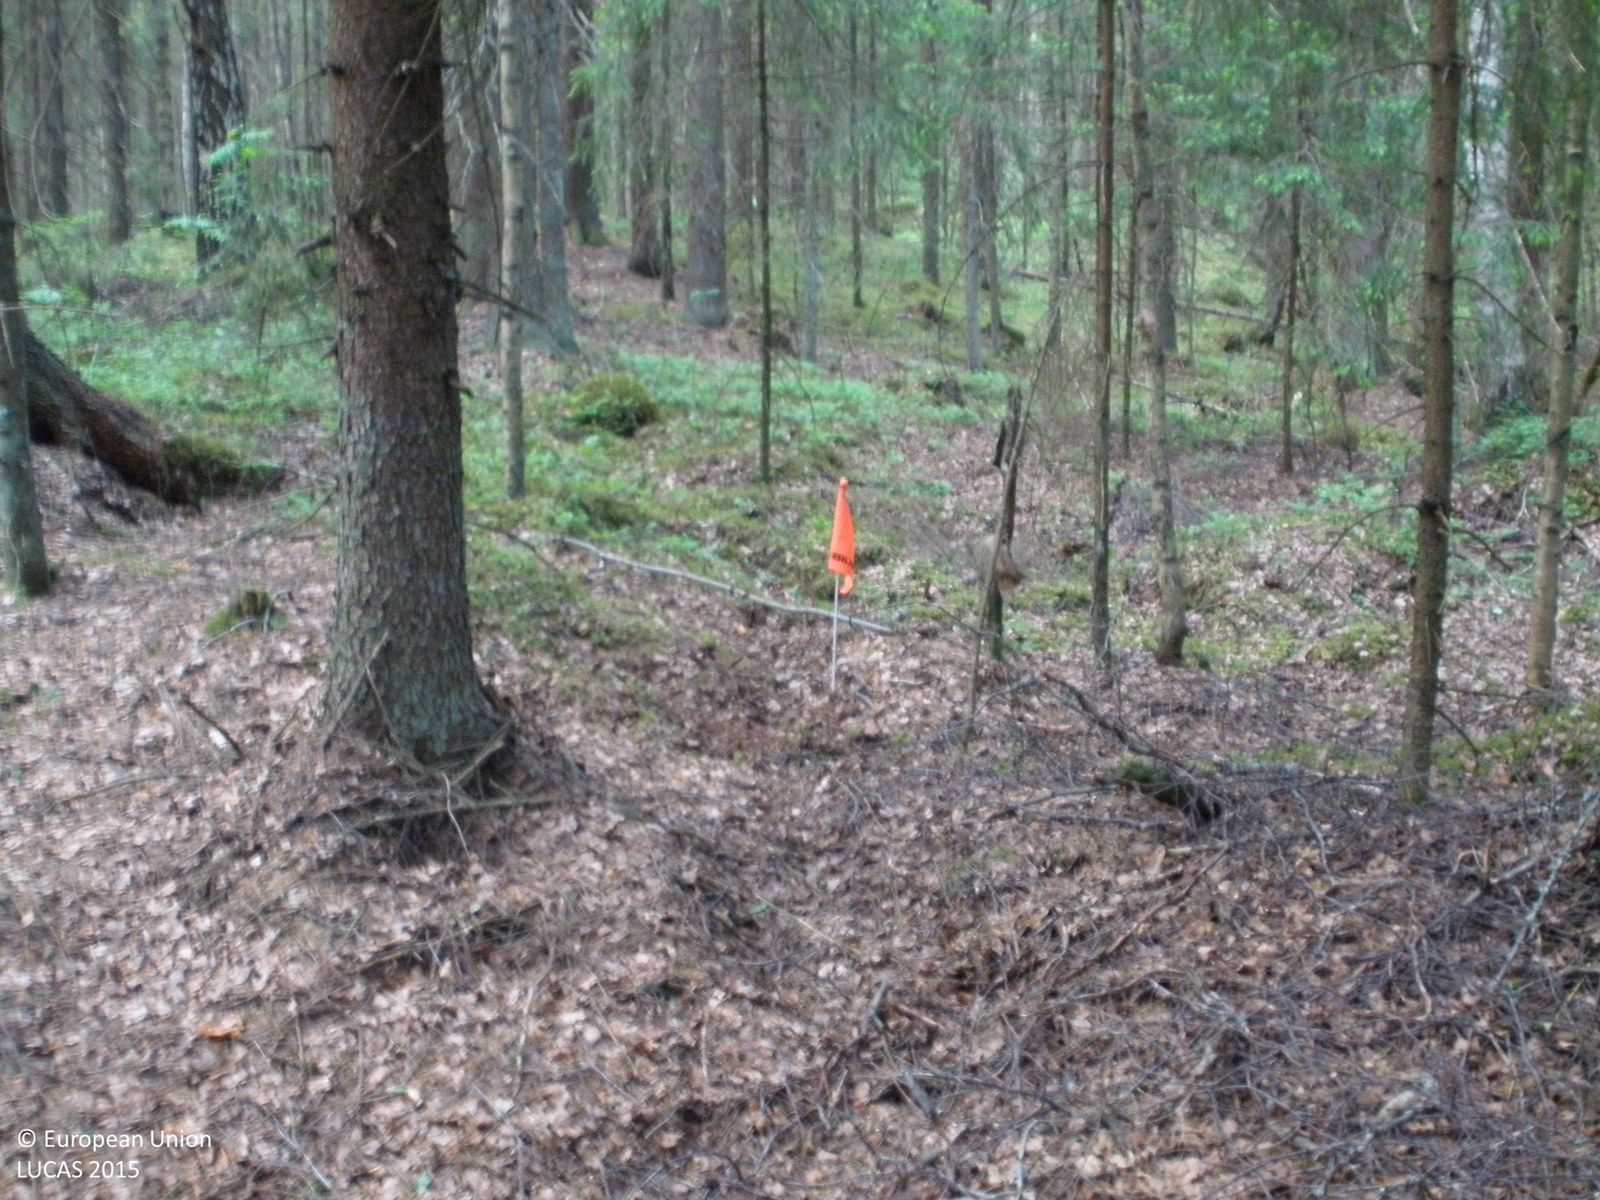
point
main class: Woodland
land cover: Spruce dominated coniferous woodland
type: boreal forest
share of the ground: > 75 %
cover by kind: coniferous forest trees 90 %, broadleaved forest trees 5 %, lichens and mosses 5 %
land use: Forestry
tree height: > 5 m
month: June
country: FI
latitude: 61.3006
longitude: 23.9212
